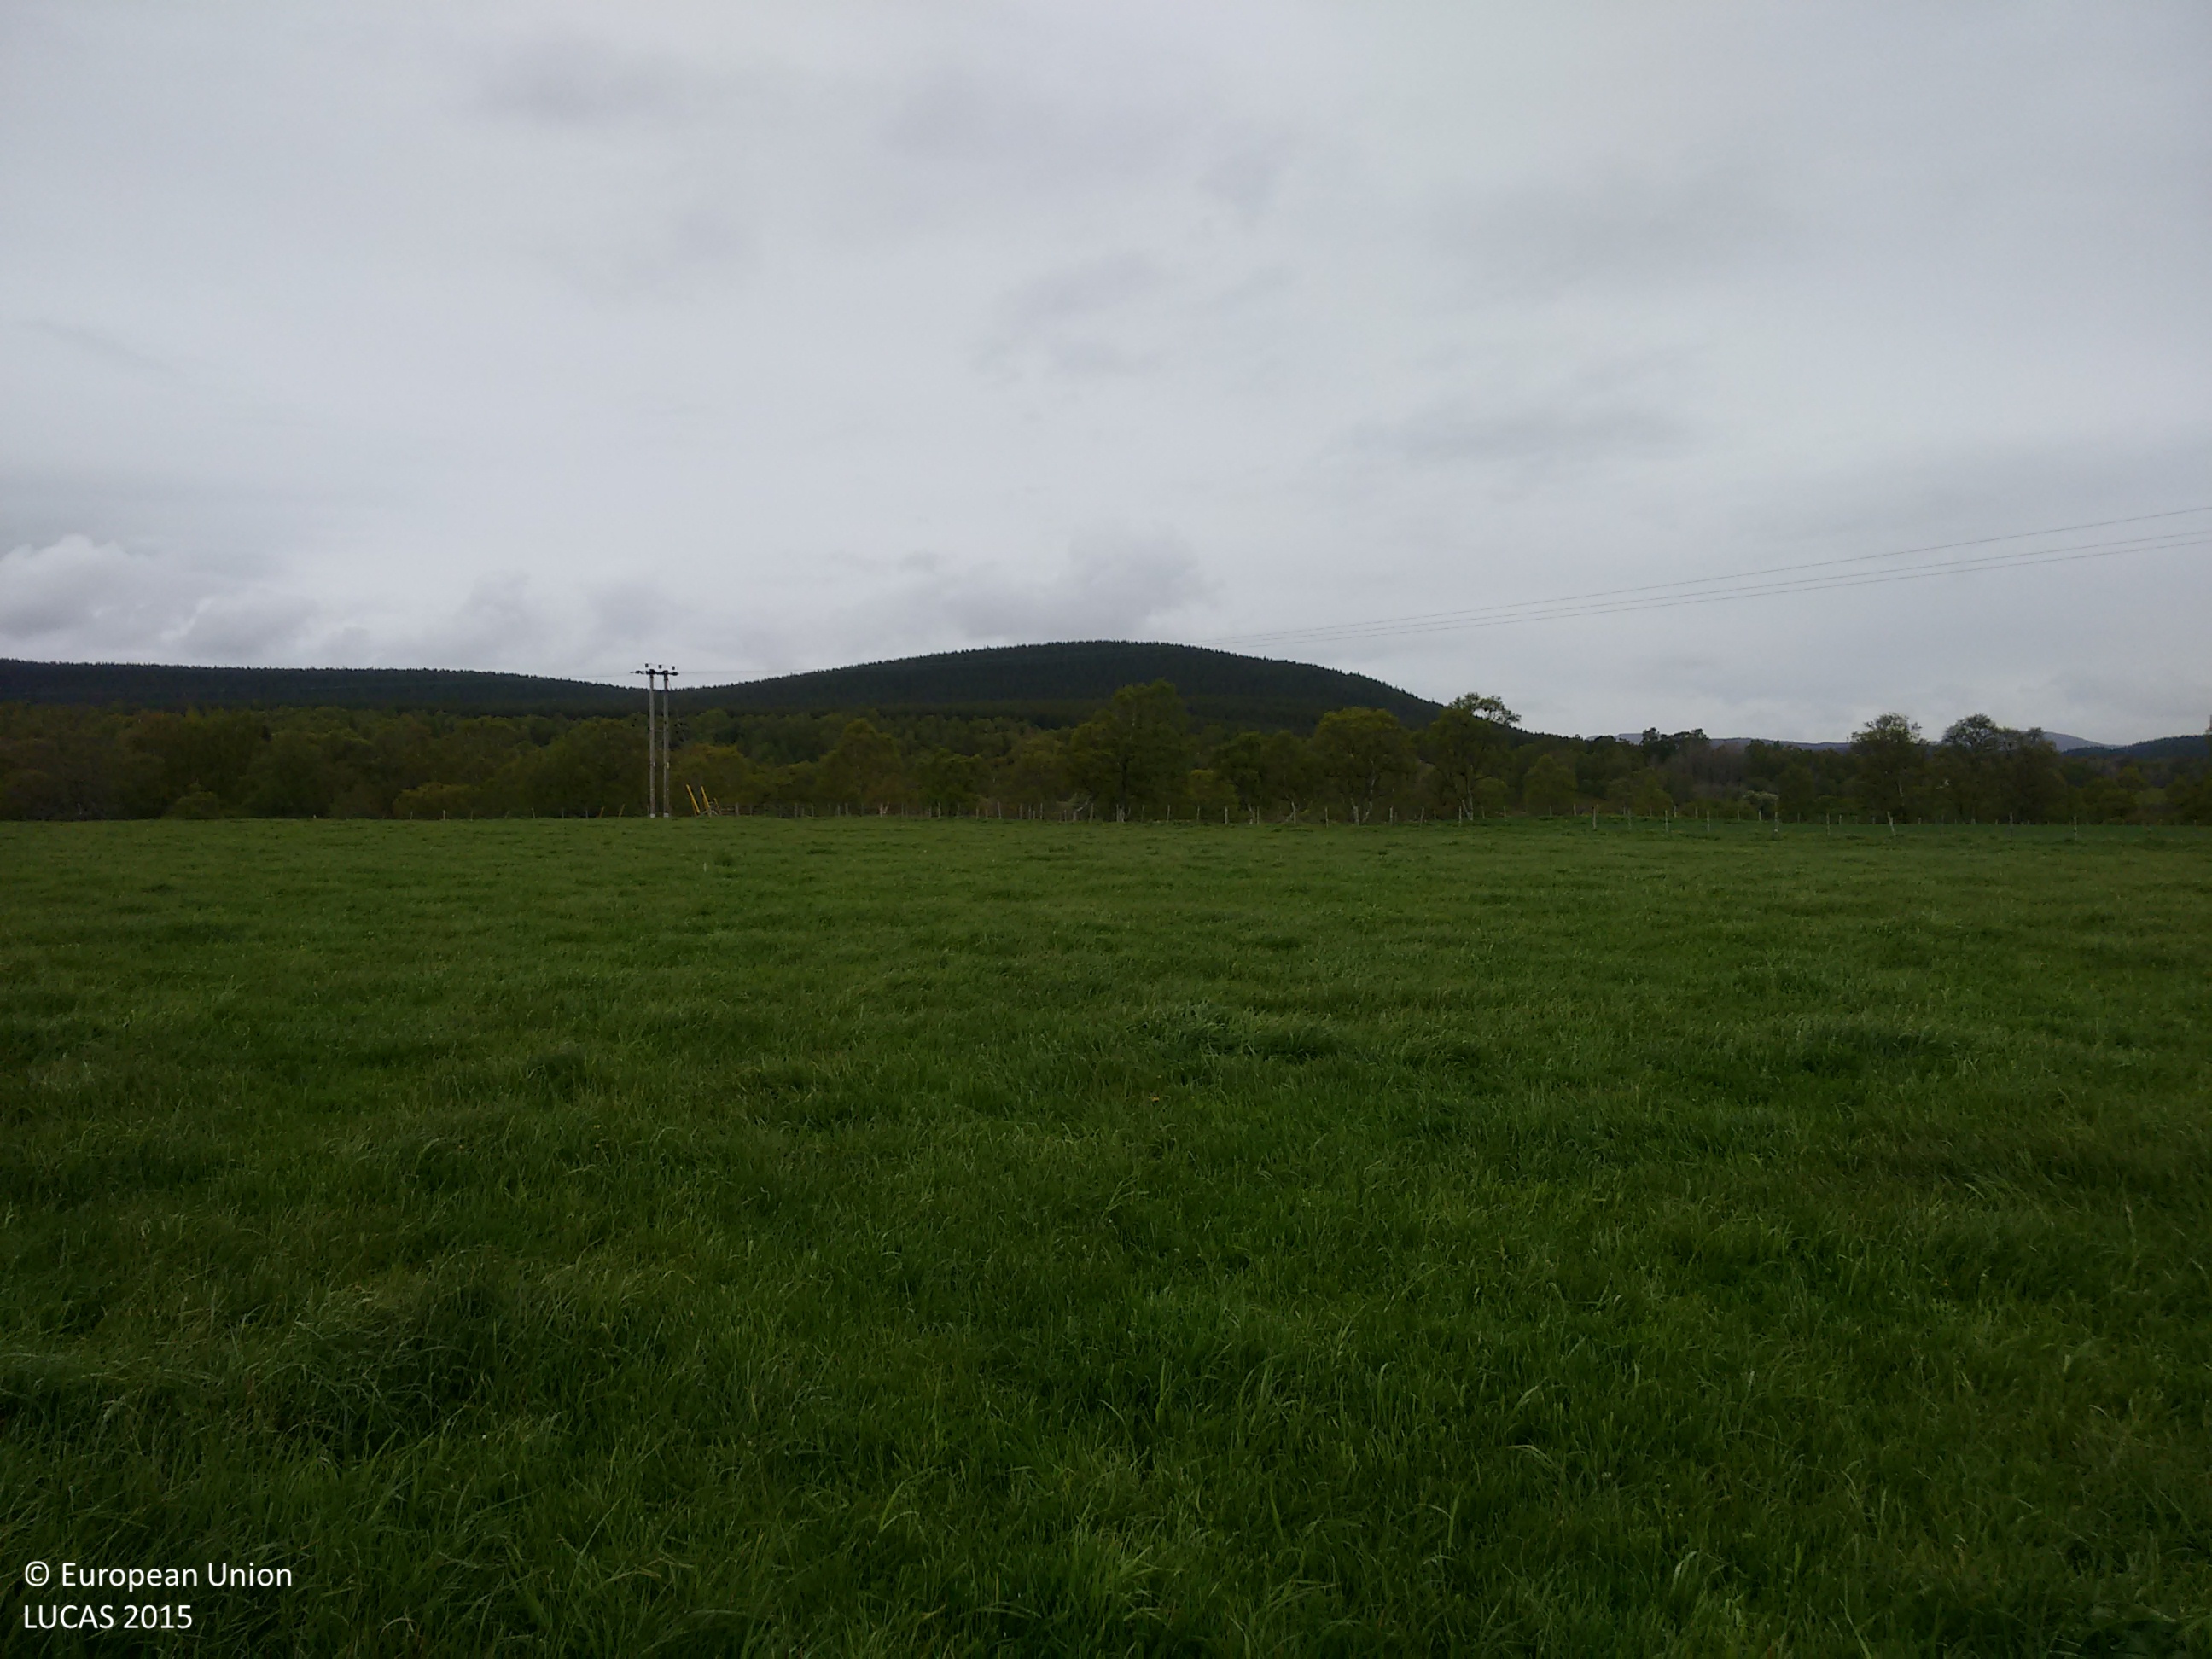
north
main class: Grassland
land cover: Grassland without tree/shrub cover
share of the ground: > 75 %
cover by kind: herbaceous plants 100 %
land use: Agriculture (excluding fallow land and kitchen gardens)
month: June
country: GB
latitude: 57.2837
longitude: -3.7965
